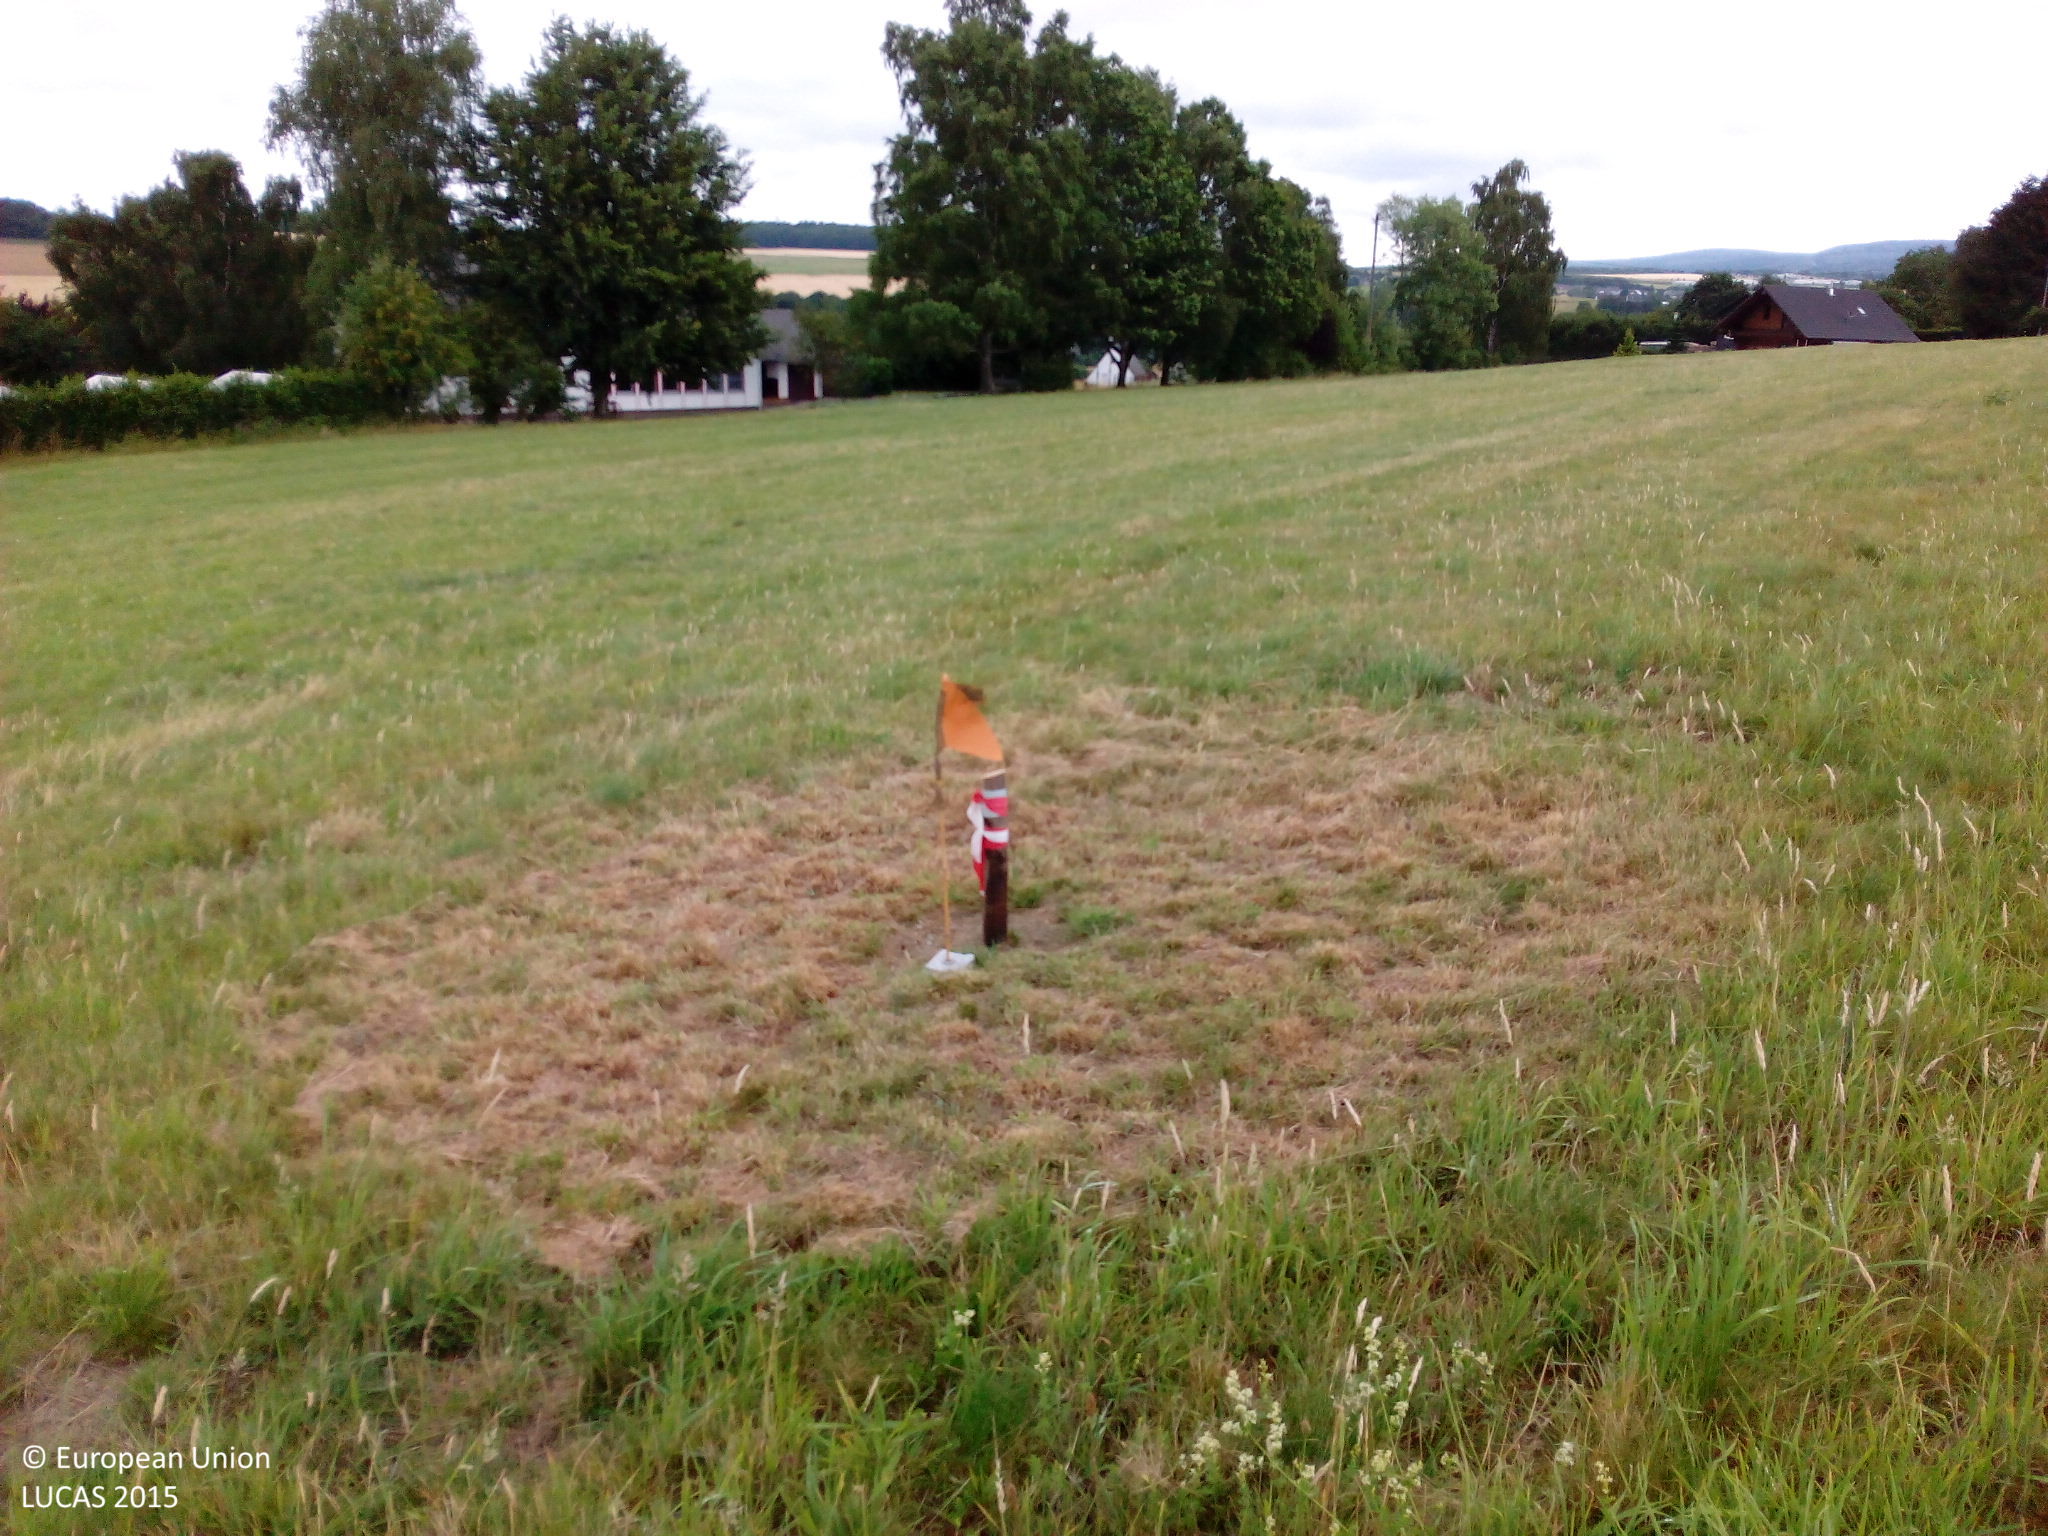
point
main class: Grassland
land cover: Grassland without tree/shrub cover
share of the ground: > 75 %
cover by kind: herbaceous plants 100 %
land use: Agriculture (excluding fallow land and kitchen gardens)
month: July
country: DE
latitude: 49.7867
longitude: 7.0695
